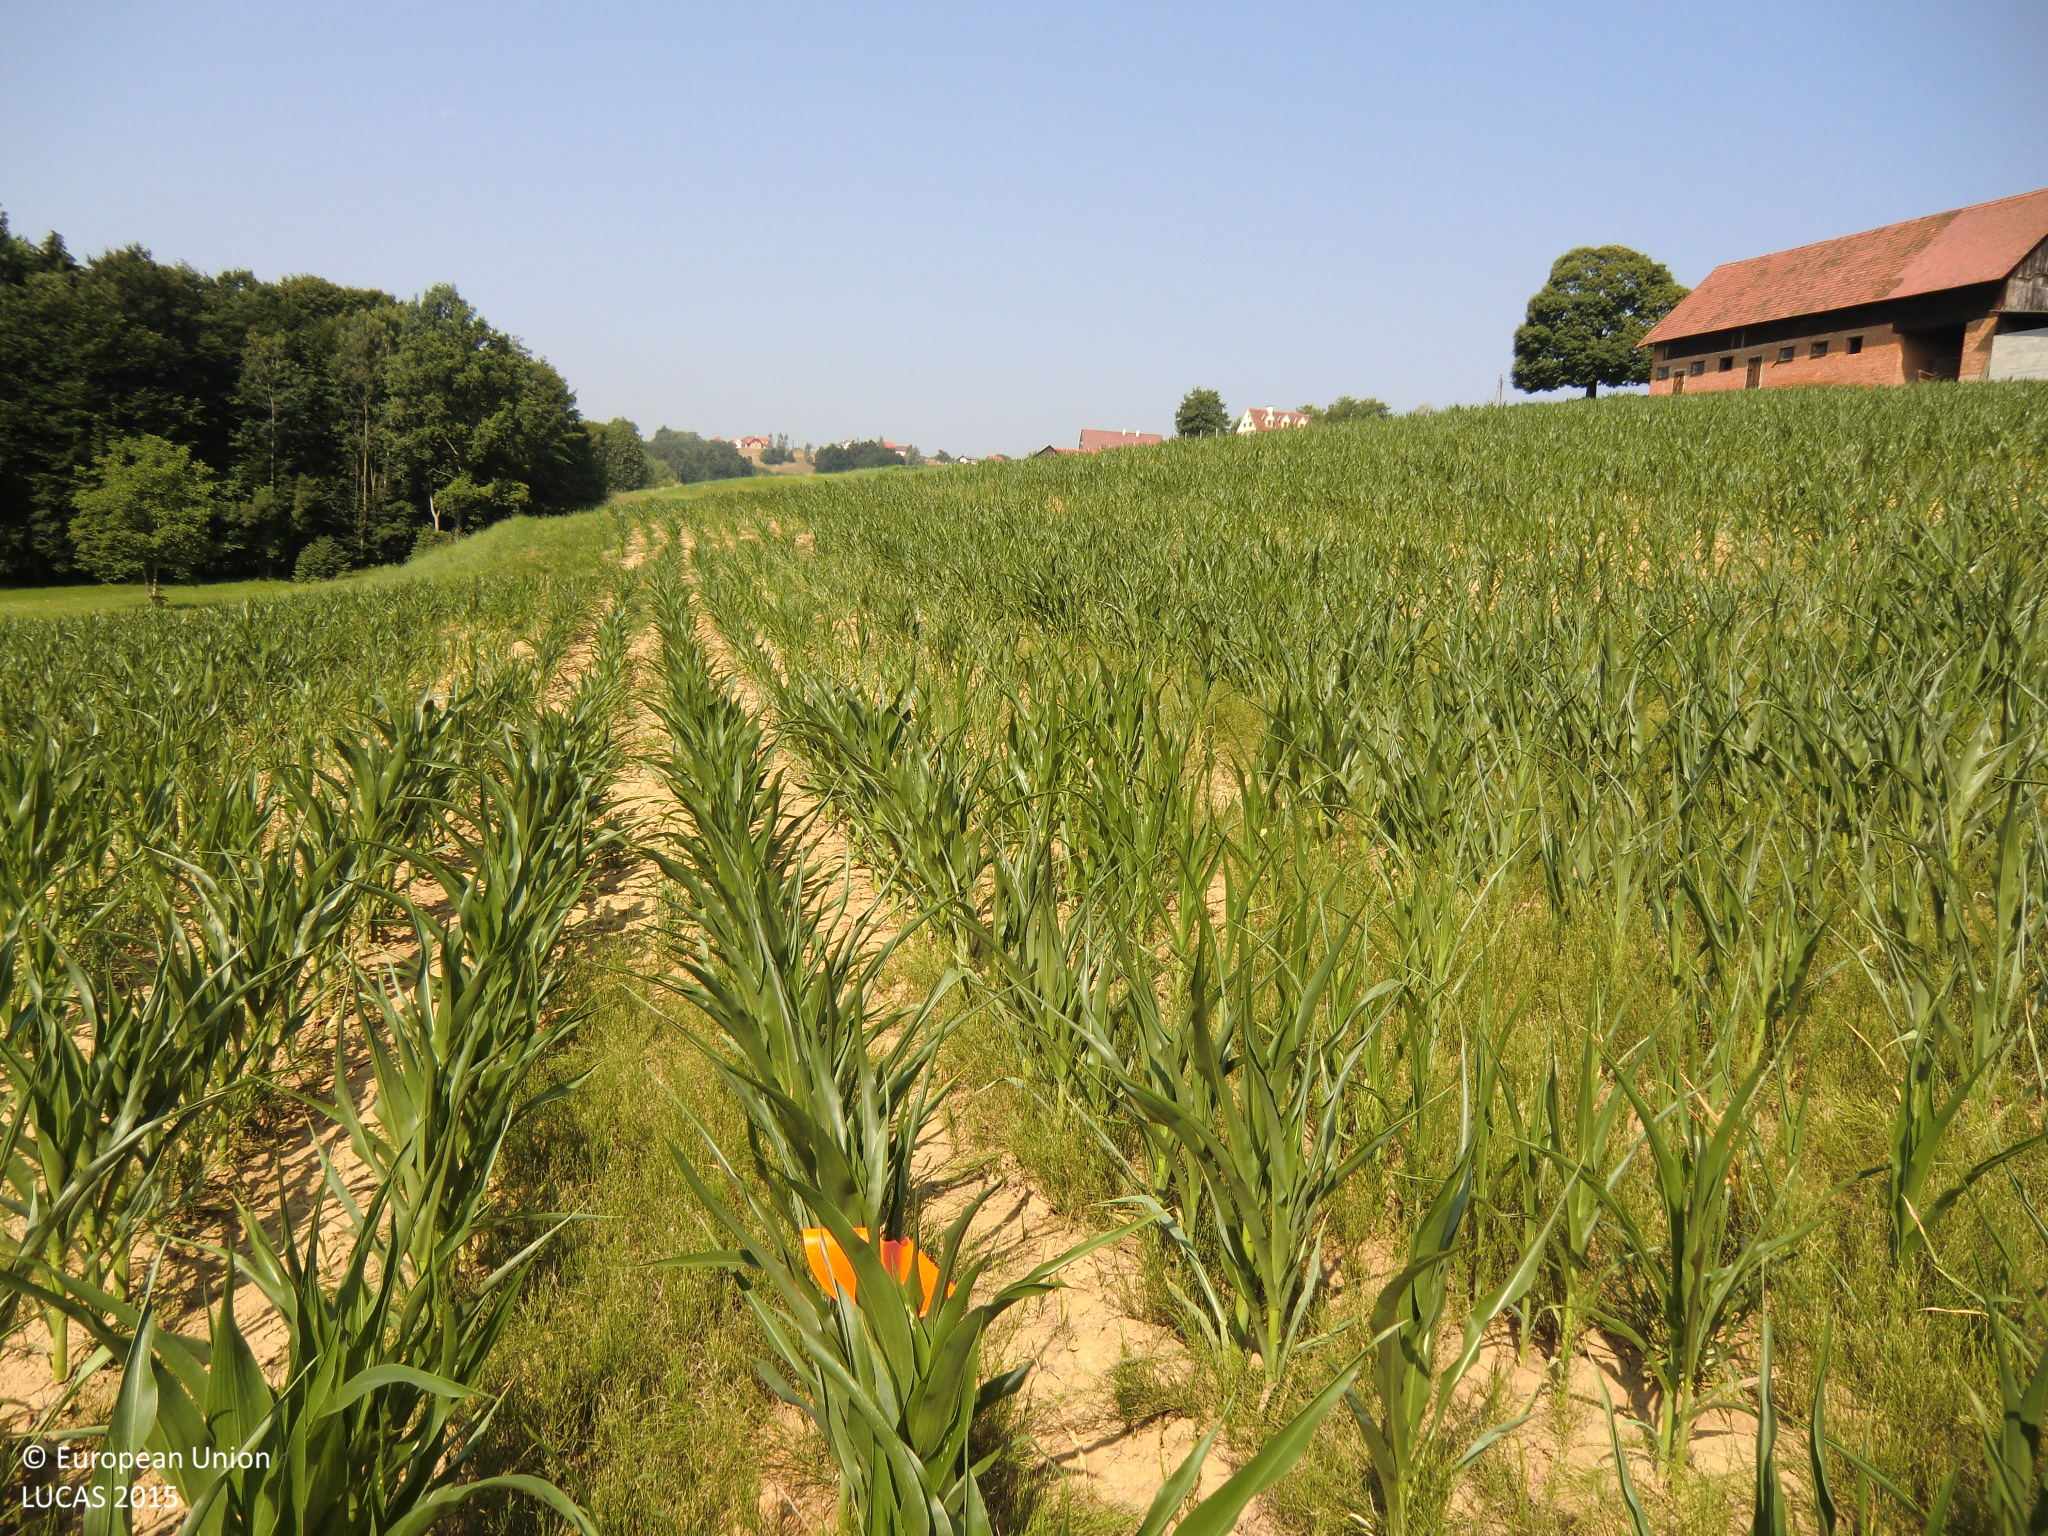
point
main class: Cropland
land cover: Maize
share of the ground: 50 - 75 %
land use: Agriculture (excluding fallow land and kitchen gardens)
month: July
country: AT
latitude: 47.1539
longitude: 15.7379
